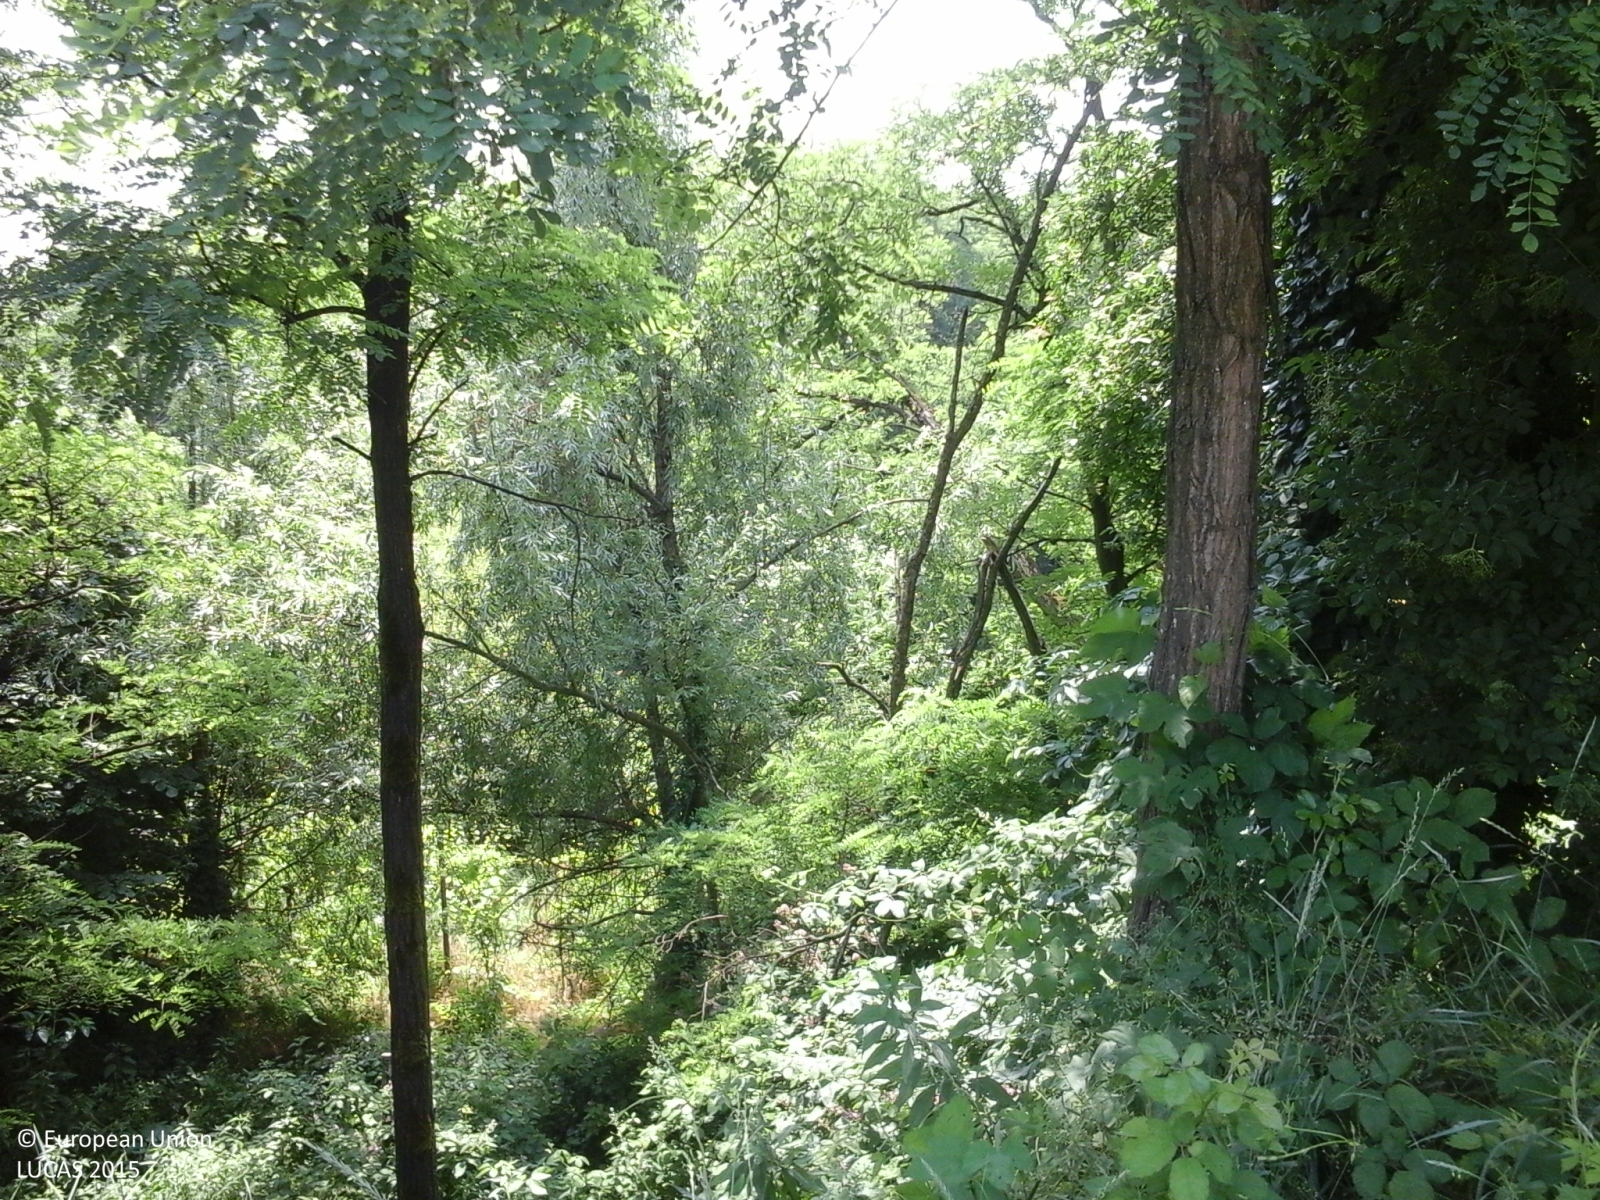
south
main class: Woodland
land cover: Broadleaved woodland
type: thermophilous deciduous forest
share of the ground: > 75 %
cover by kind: broadleaved forest trees 100 %
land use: Forestry
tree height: > 5 m
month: June
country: IT
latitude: 45.1786
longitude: 9.4538
